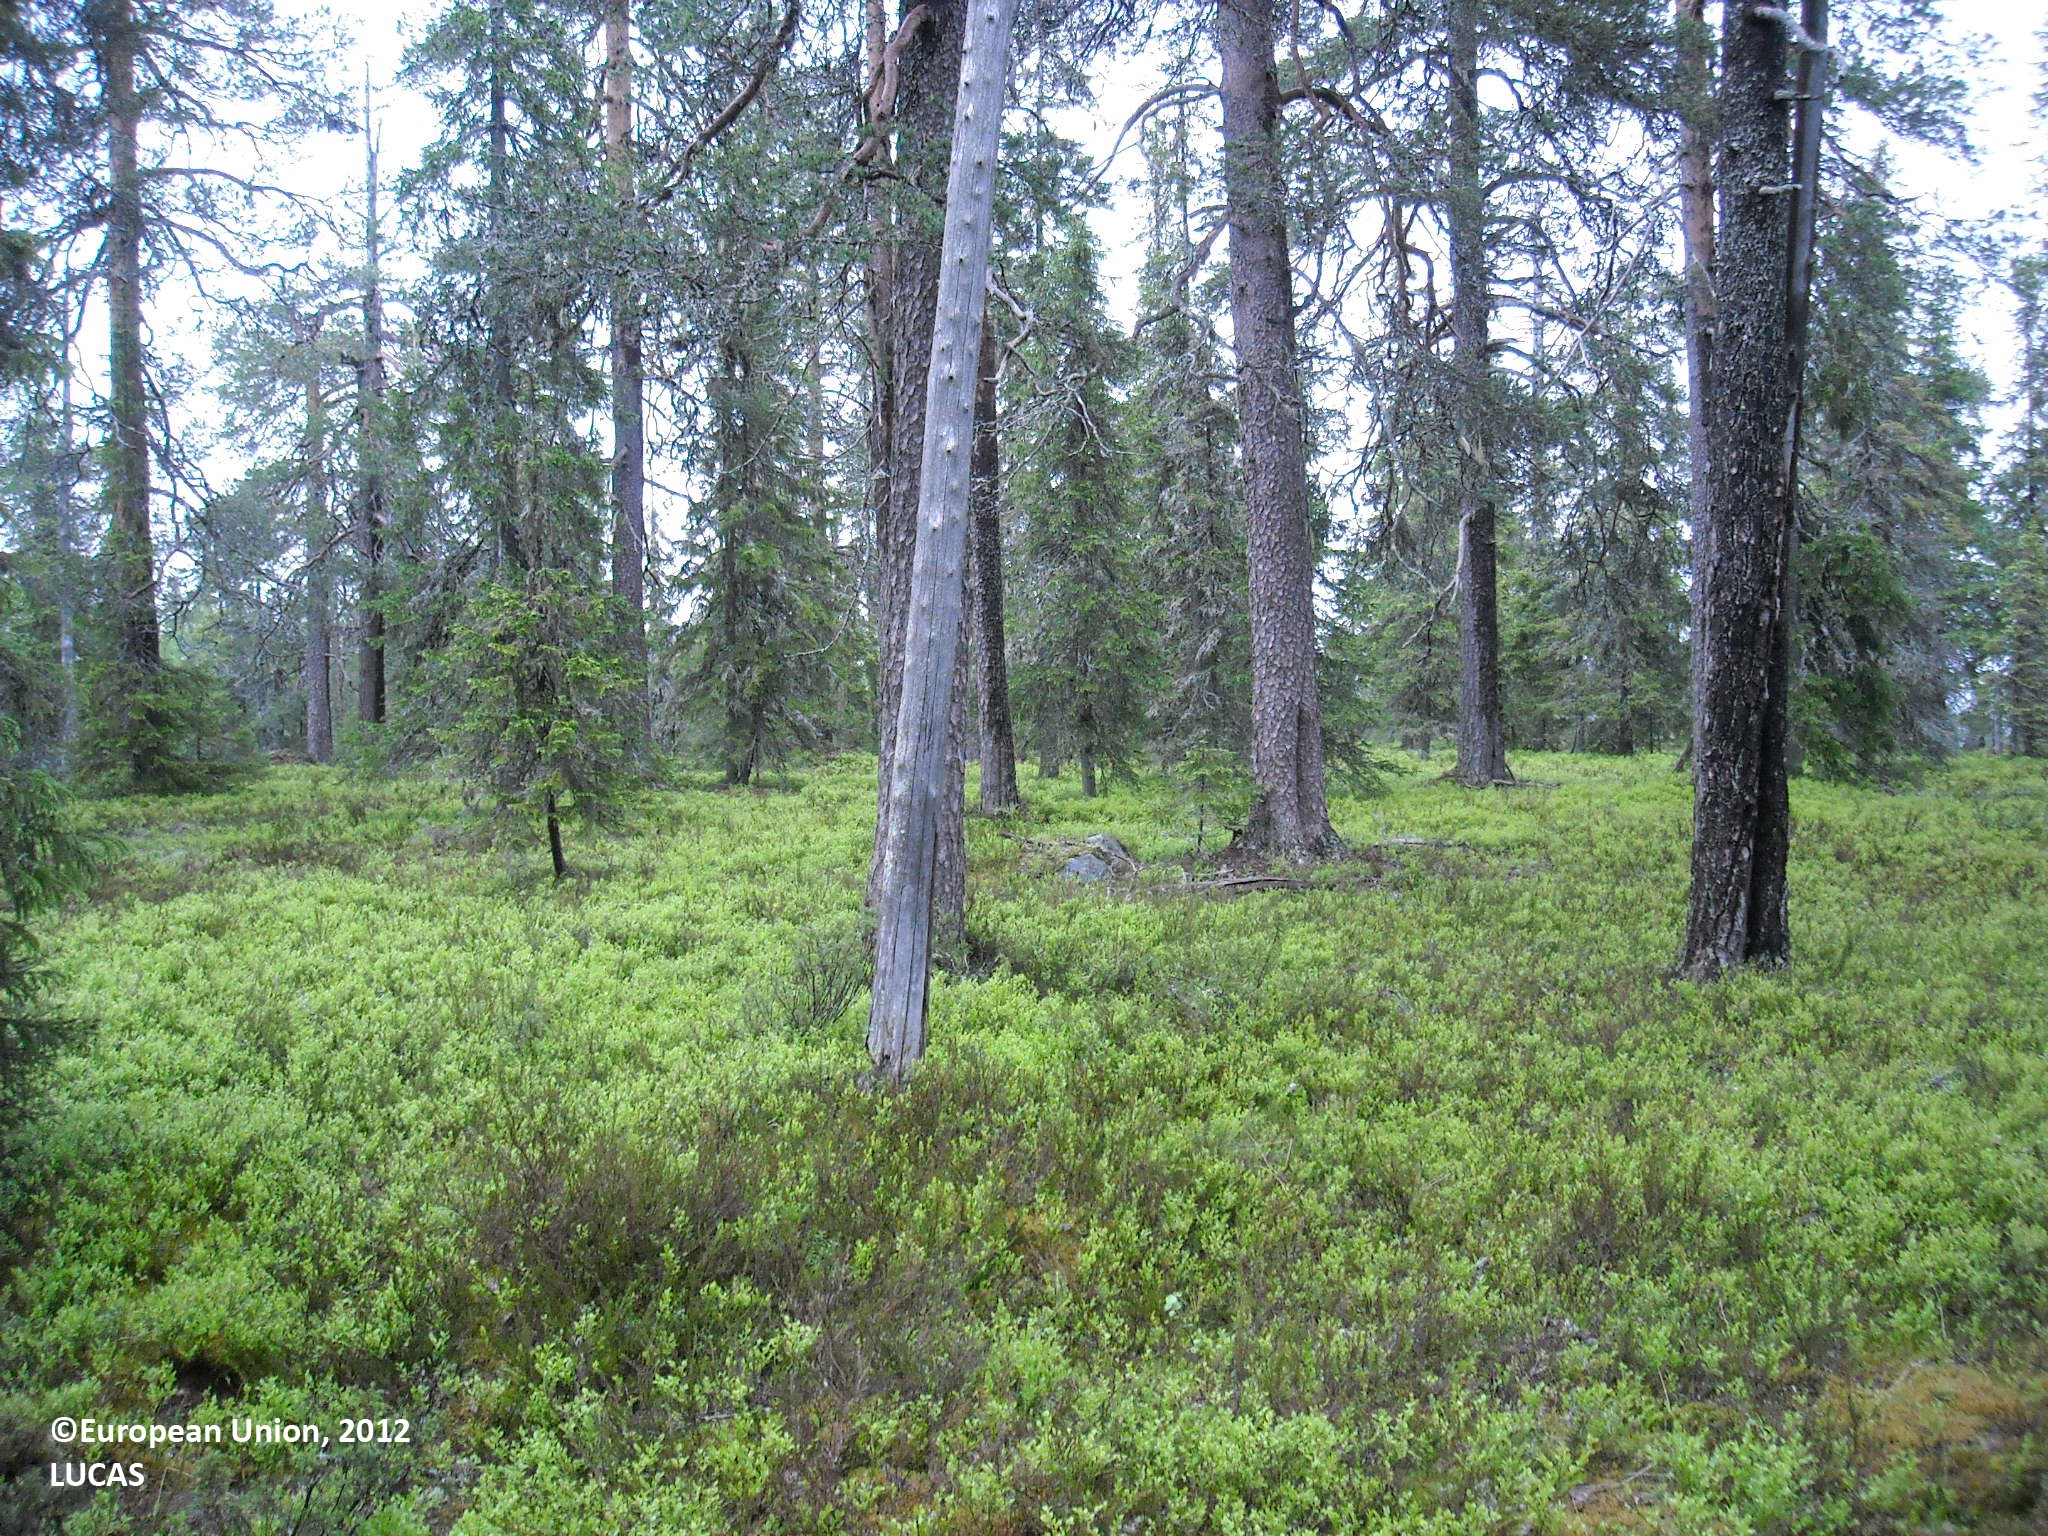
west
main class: Woodland
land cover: Other coniferous woodland
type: boreal forest
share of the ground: > 75 %
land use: Forestry
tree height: > 5 m
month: June
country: FI
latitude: 65.5908
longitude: 27.8569
